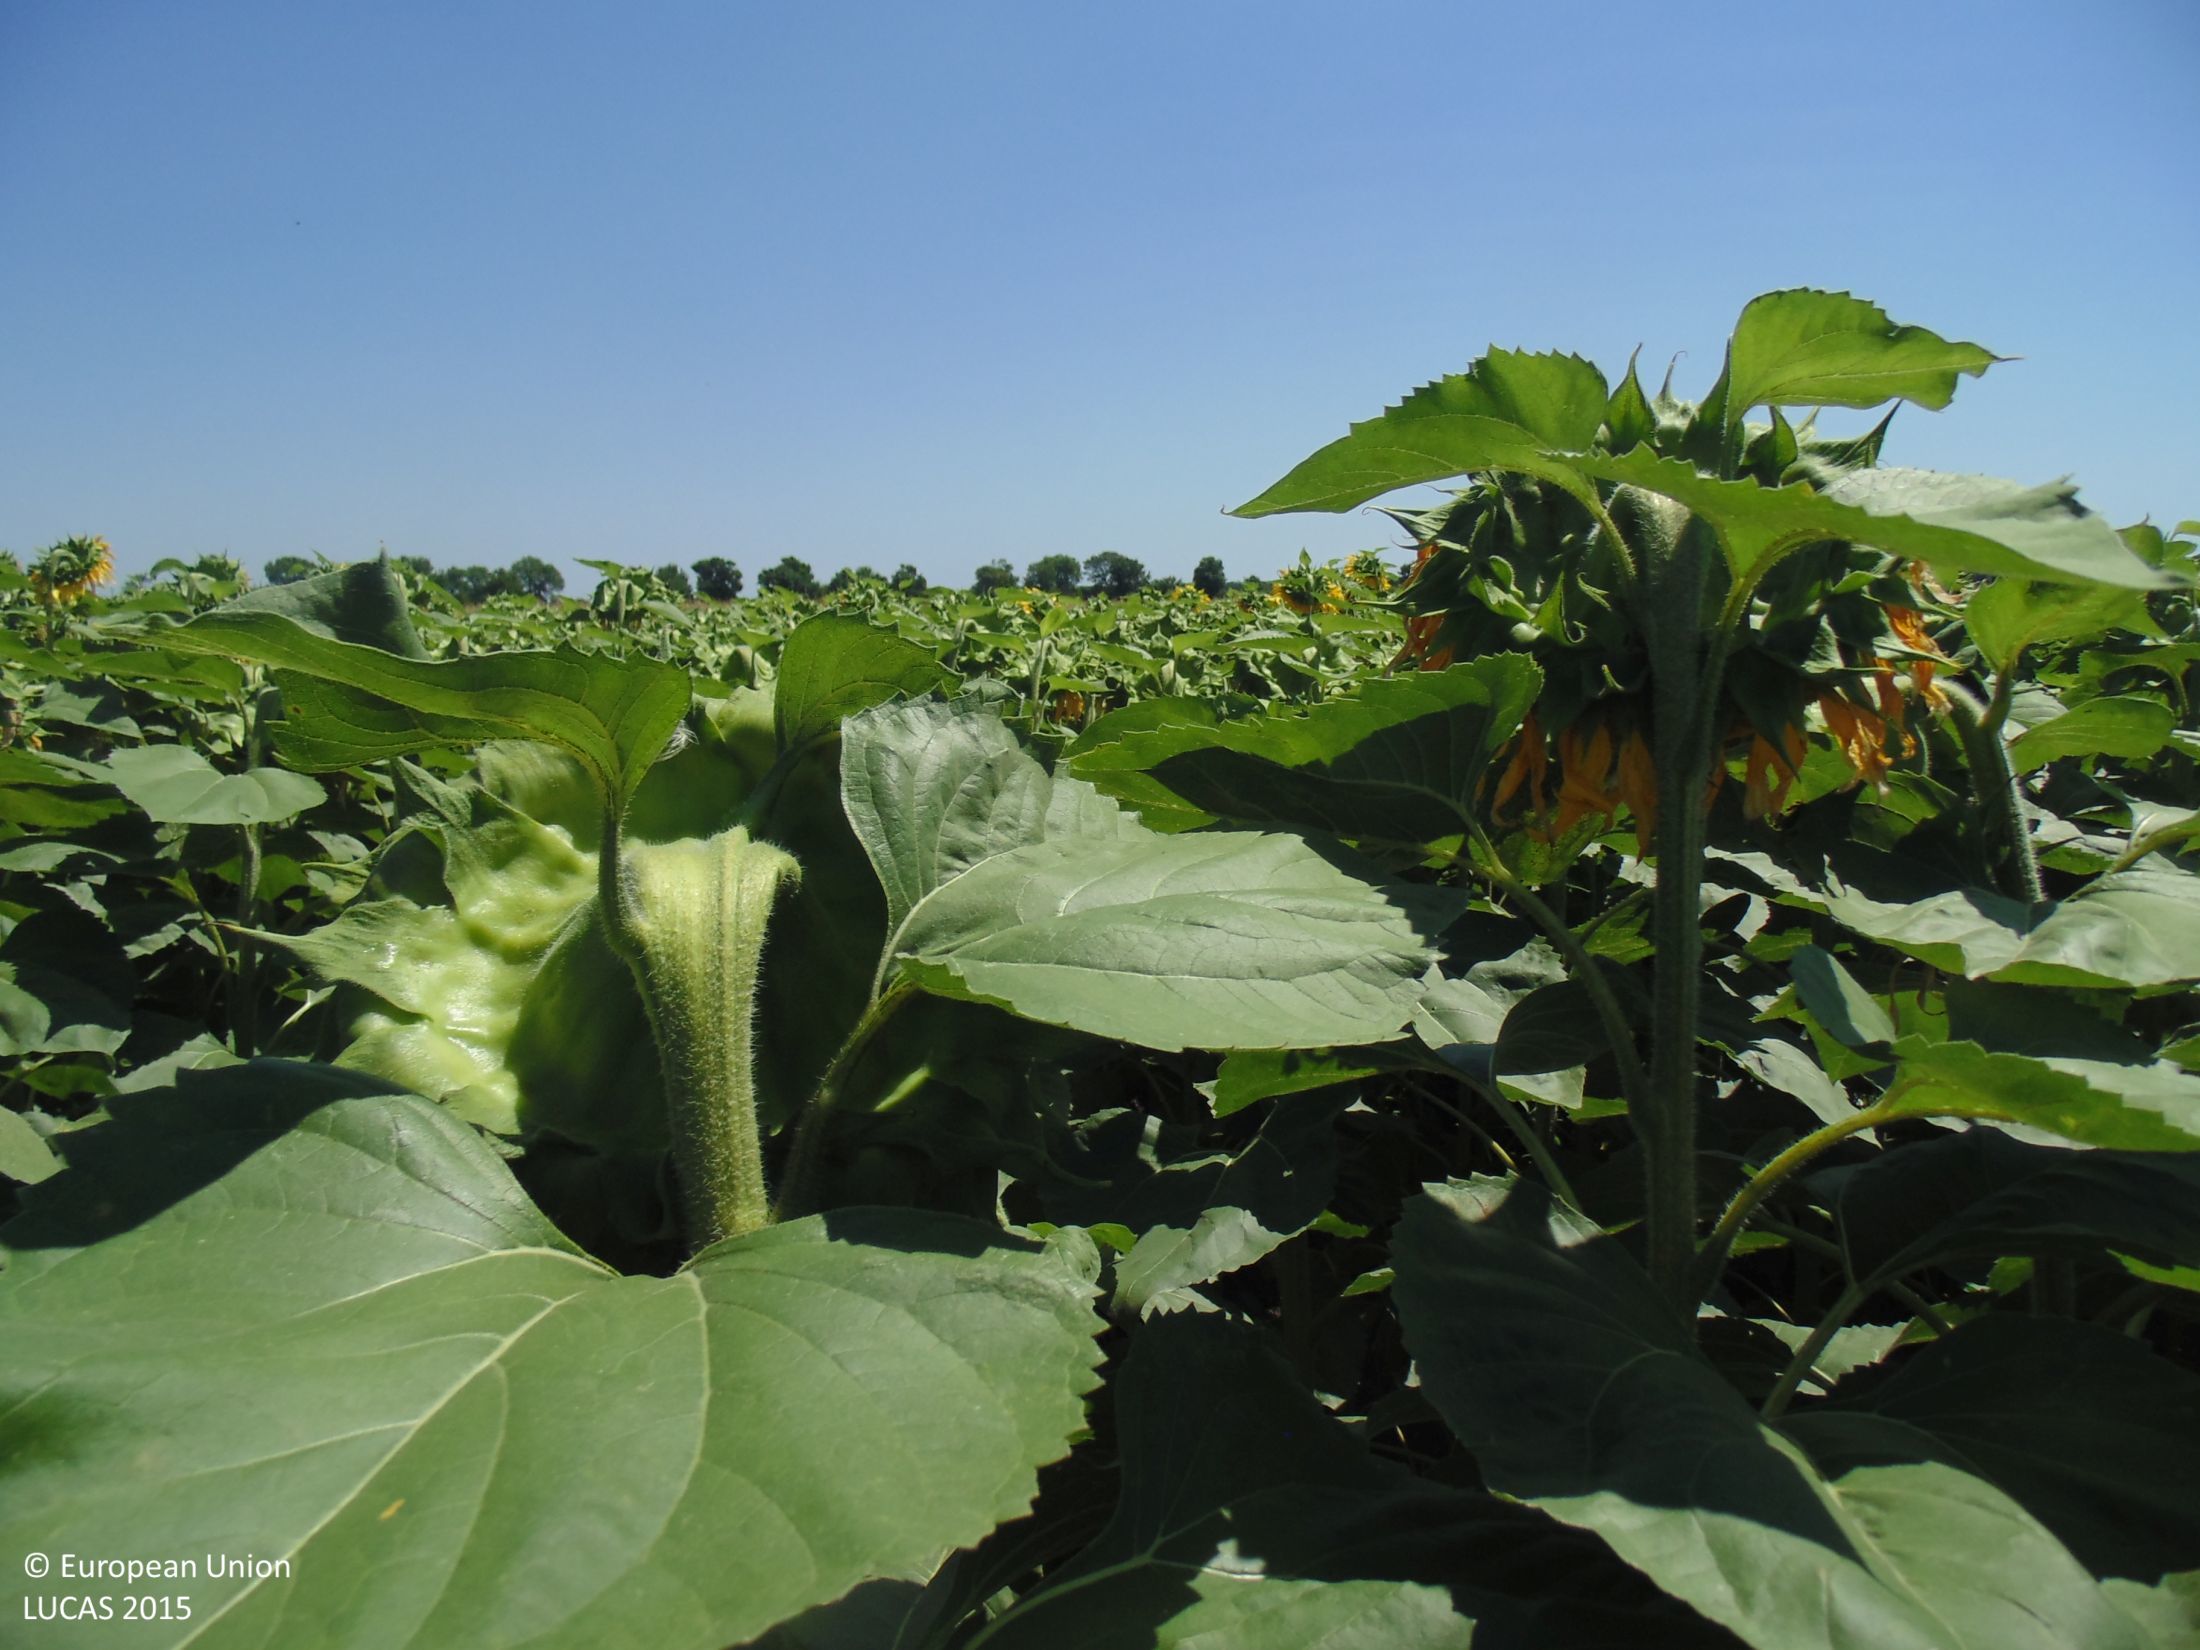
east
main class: Cropland
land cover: Sunflower
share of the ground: > 75 %
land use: Agriculture (excluding fallow land and kitchen gardens)
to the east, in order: Sunflower; Tracks; Grass margins; Maize; Grass margins; Tracks; Grass margins; Sunflower; Grass margins; Vineyards
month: July
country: BG
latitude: 43.4478
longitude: 28.1789
